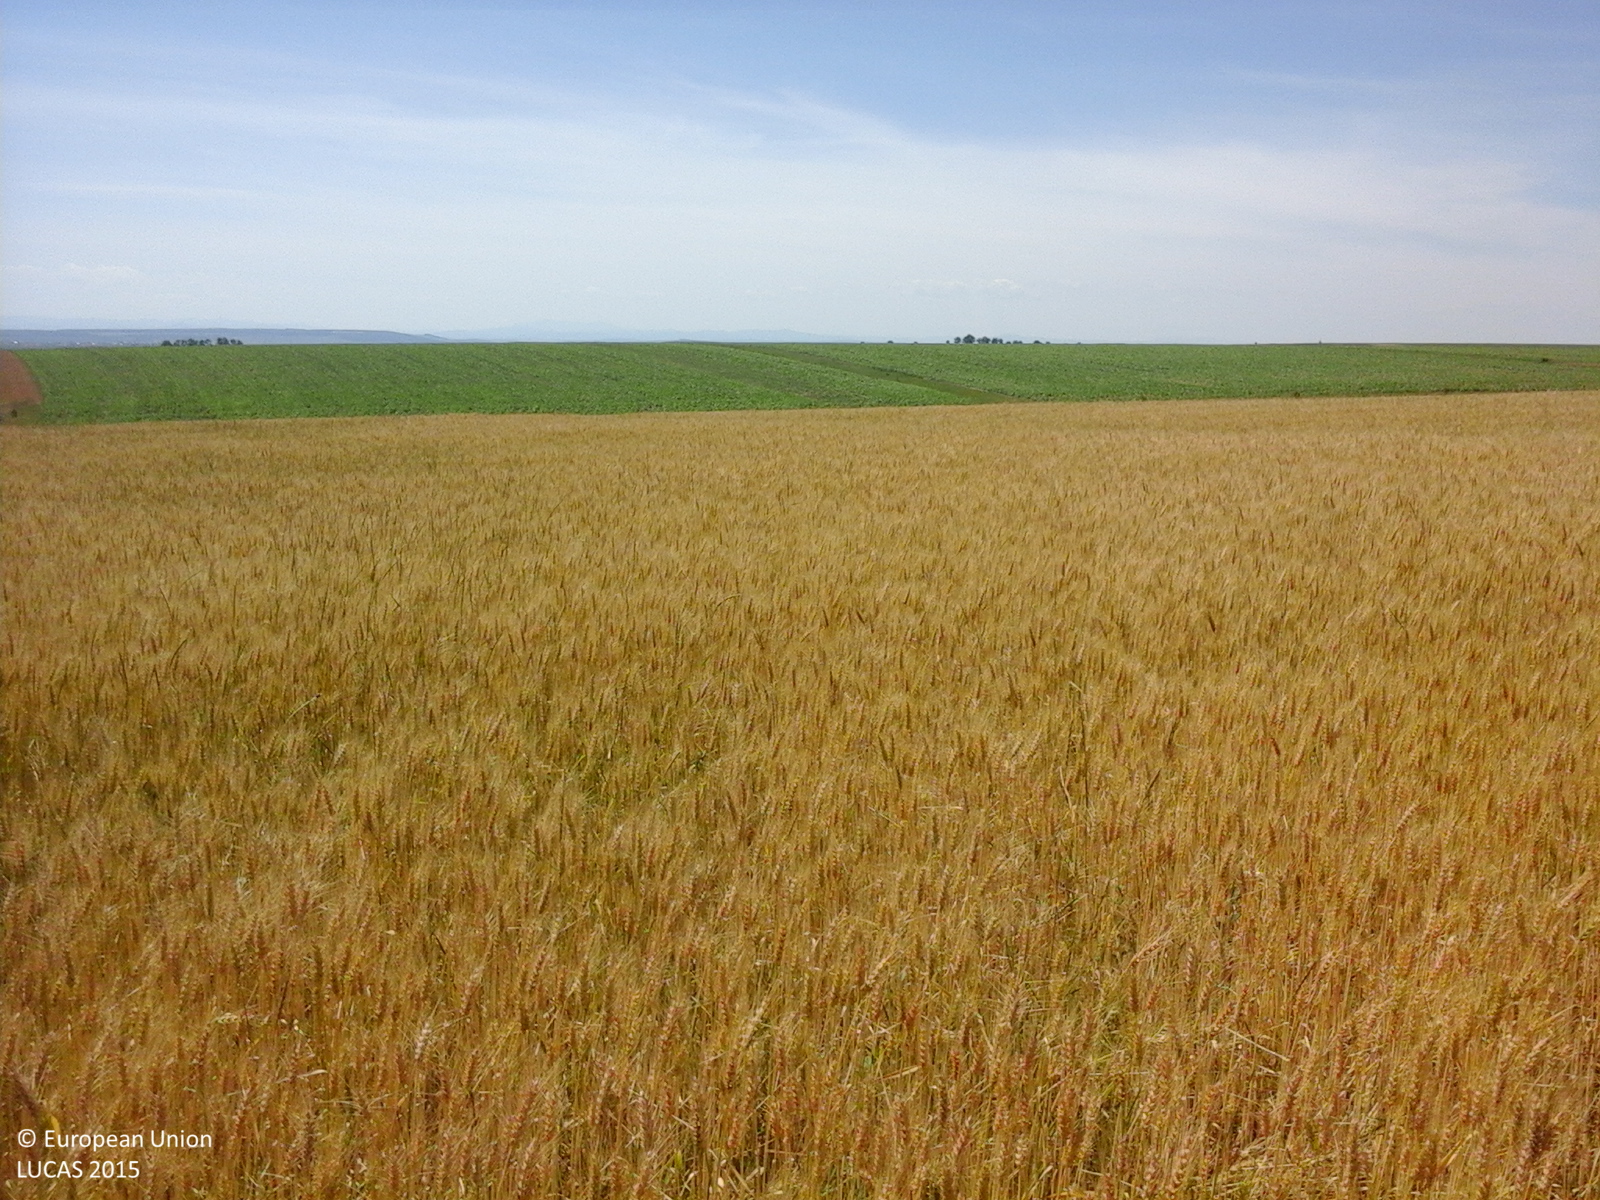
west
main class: Cropland
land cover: Common wheat
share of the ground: > 75 %
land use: Agriculture (excluding fallow land and kitchen gardens)
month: June
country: RO
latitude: 47.0571
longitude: 26.9906
